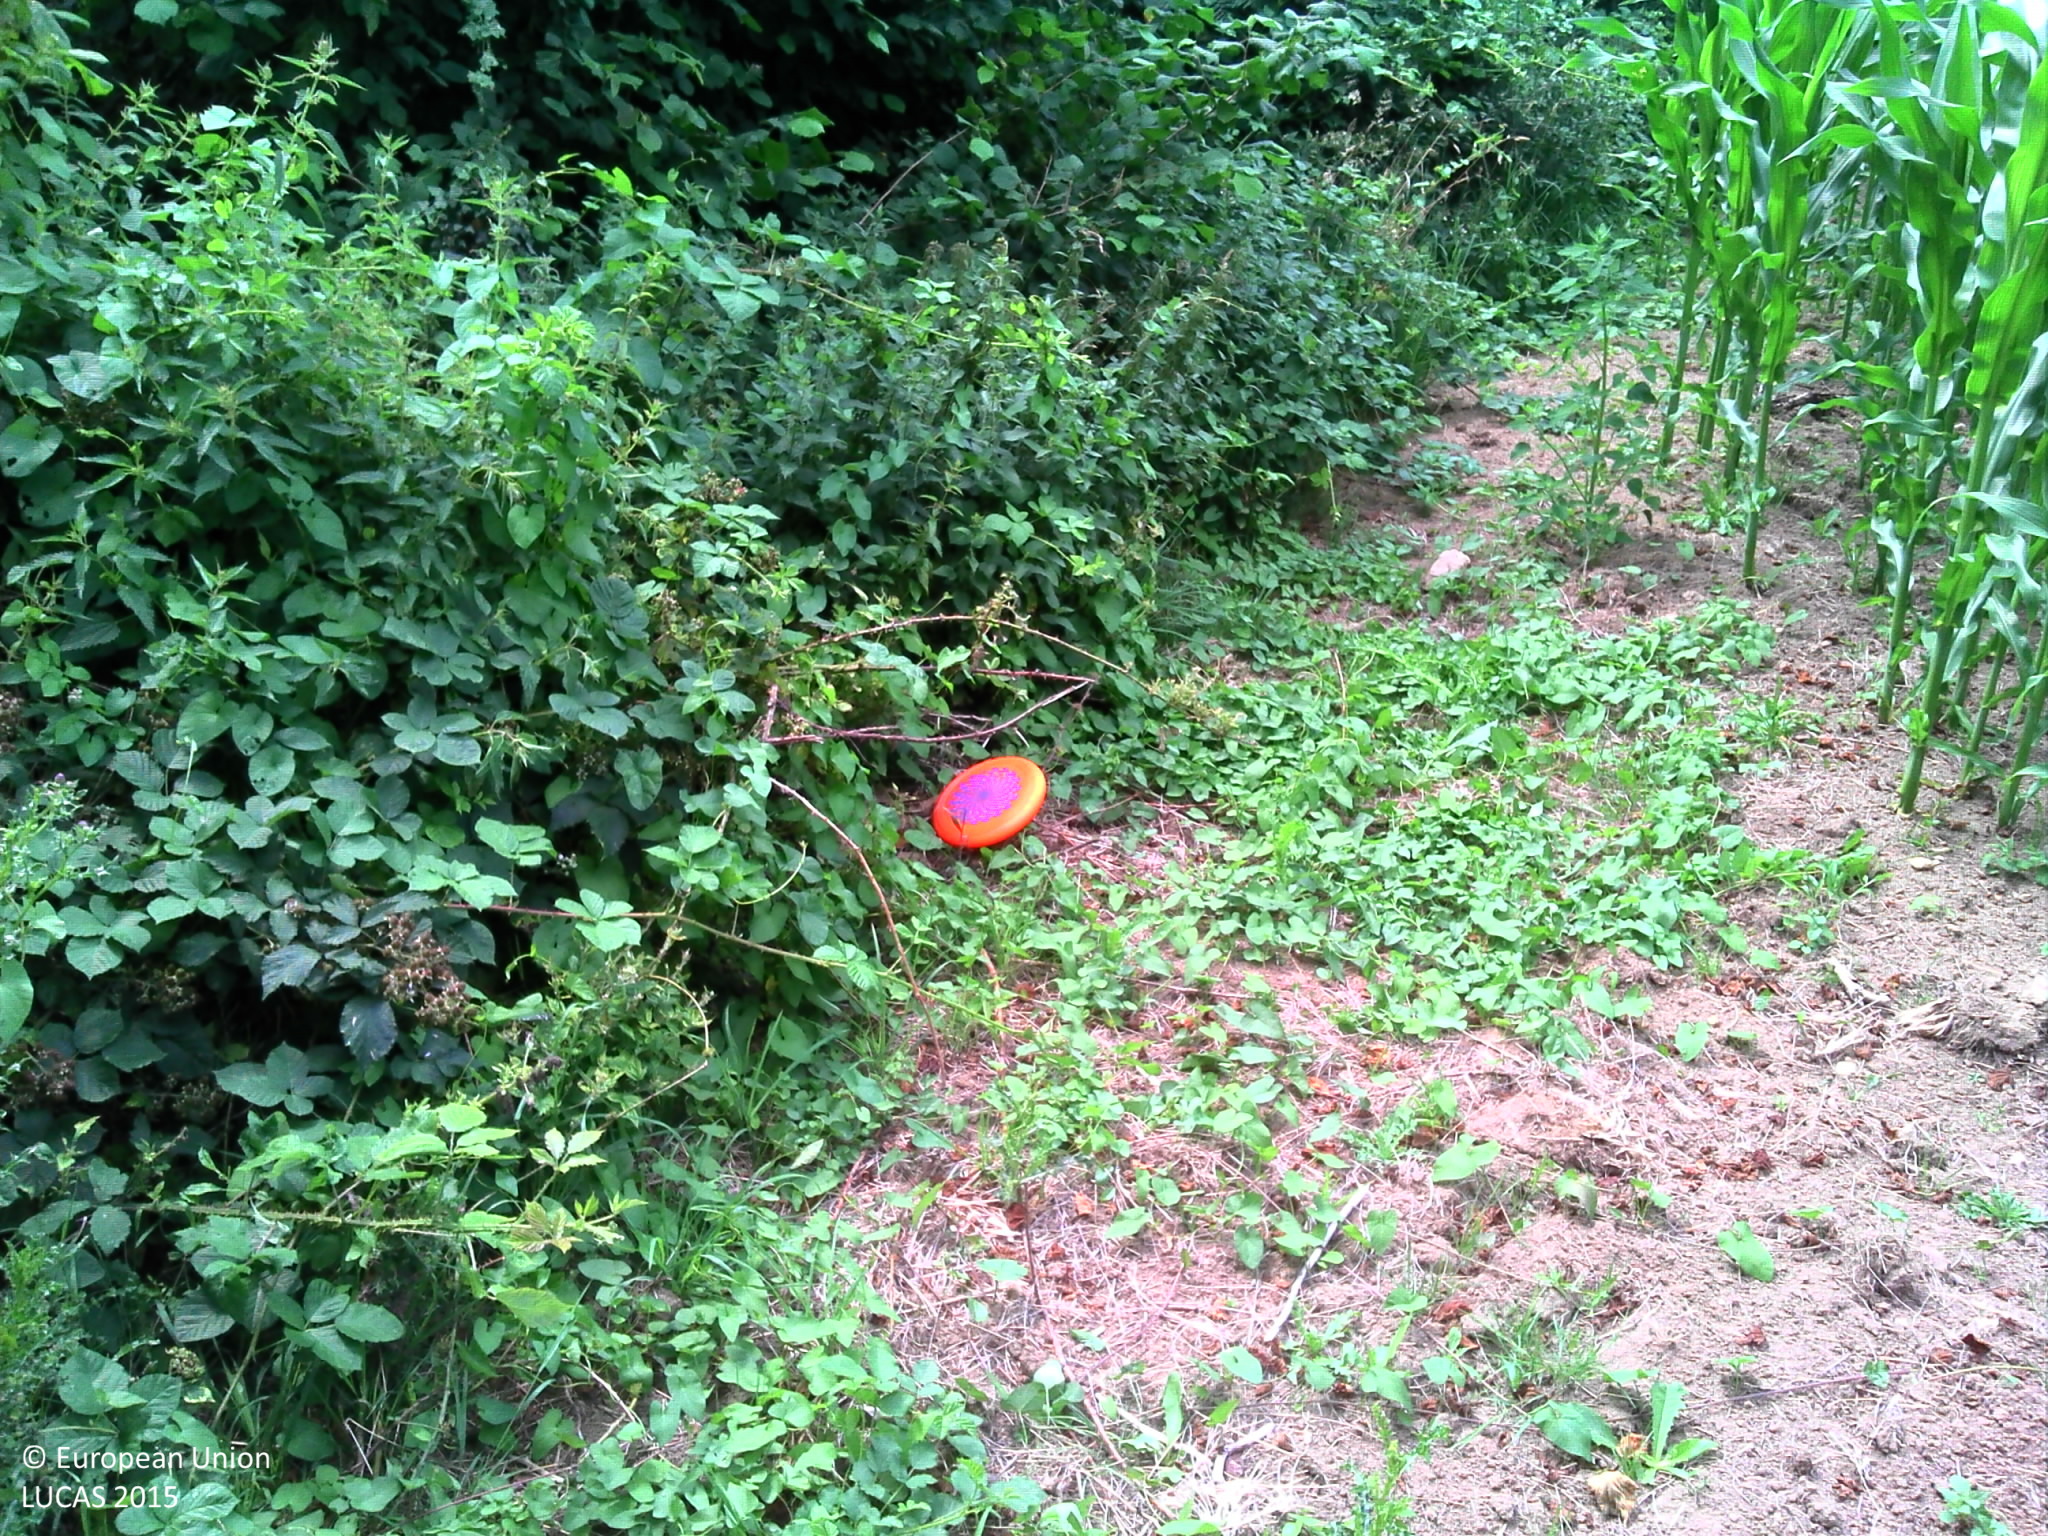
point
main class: Cropland
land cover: Maize
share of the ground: > 75 %
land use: Agriculture (excluding fallow land and kitchen gardens)
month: July
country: FR
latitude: 48.5467
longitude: -0.2049
